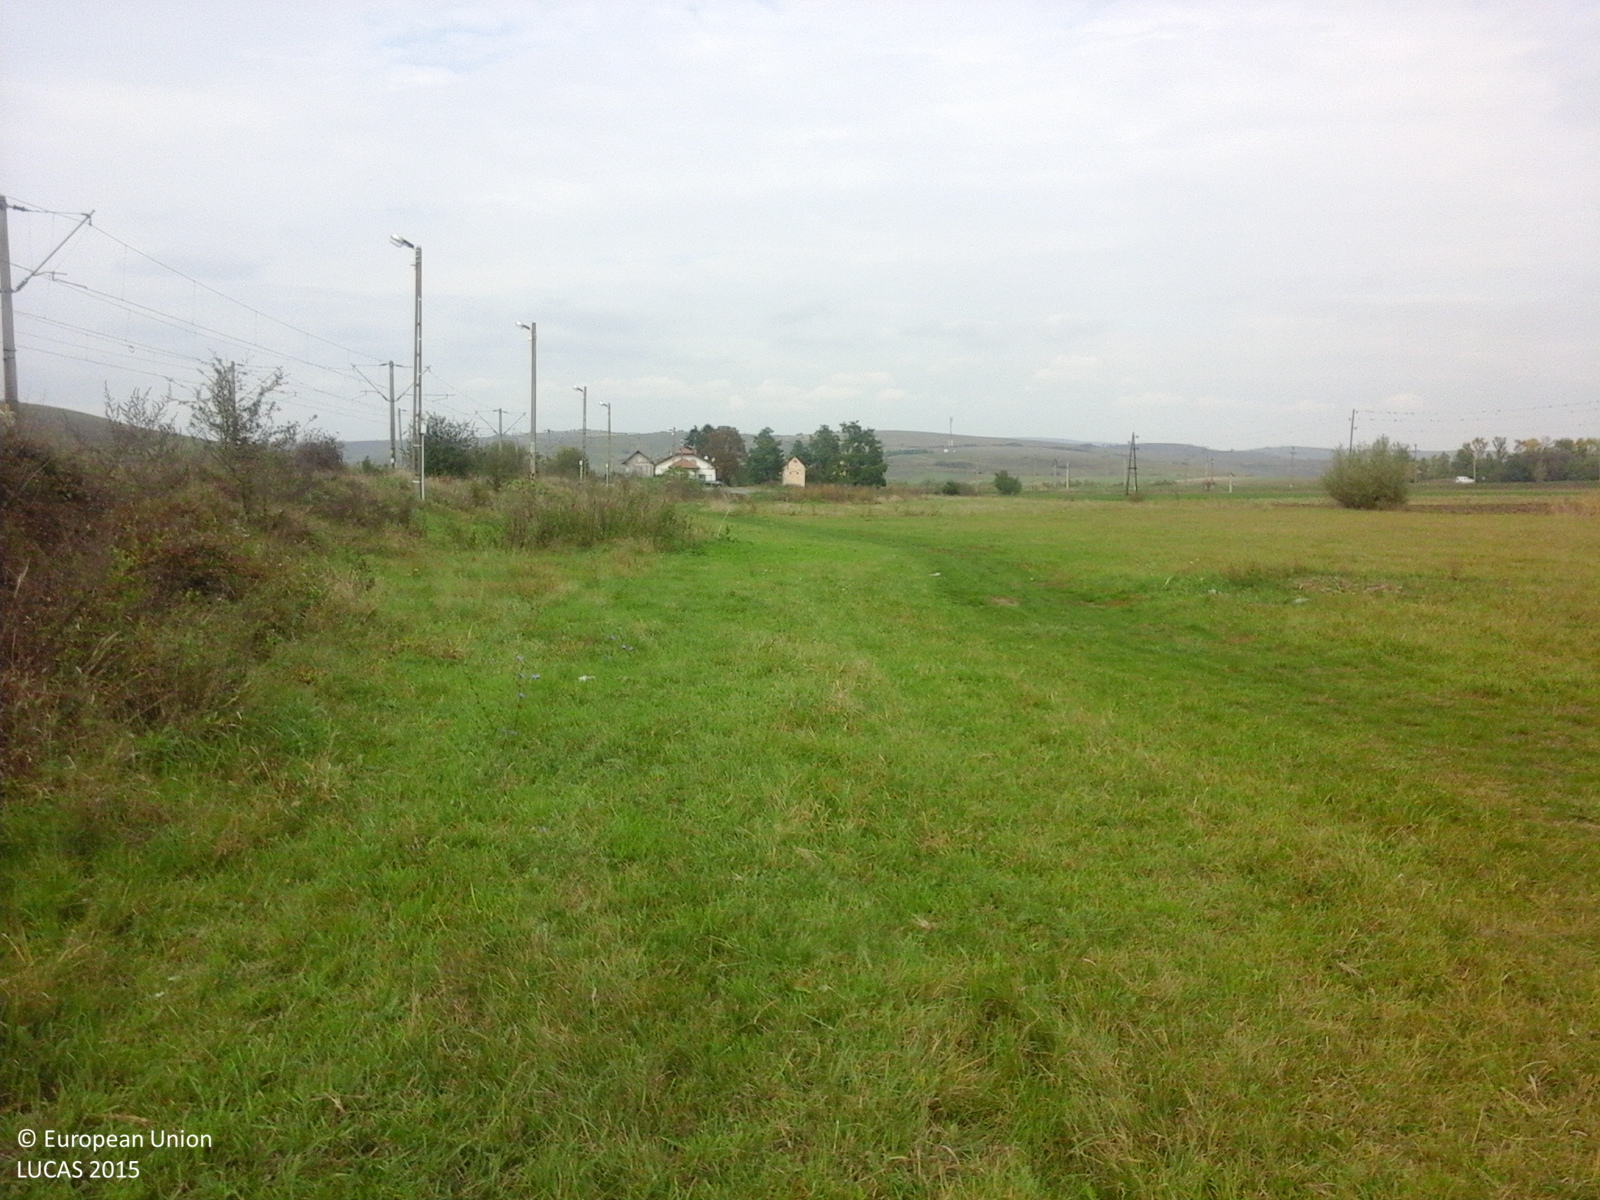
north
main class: Grassland
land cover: Grassland without tree/shrub cover
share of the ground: > 75 %
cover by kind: herbaceous plants 100 %
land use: Agriculture (excluding fallow land and kitchen gardens)
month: October
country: RO
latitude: 46.0892
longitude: 25.2711
